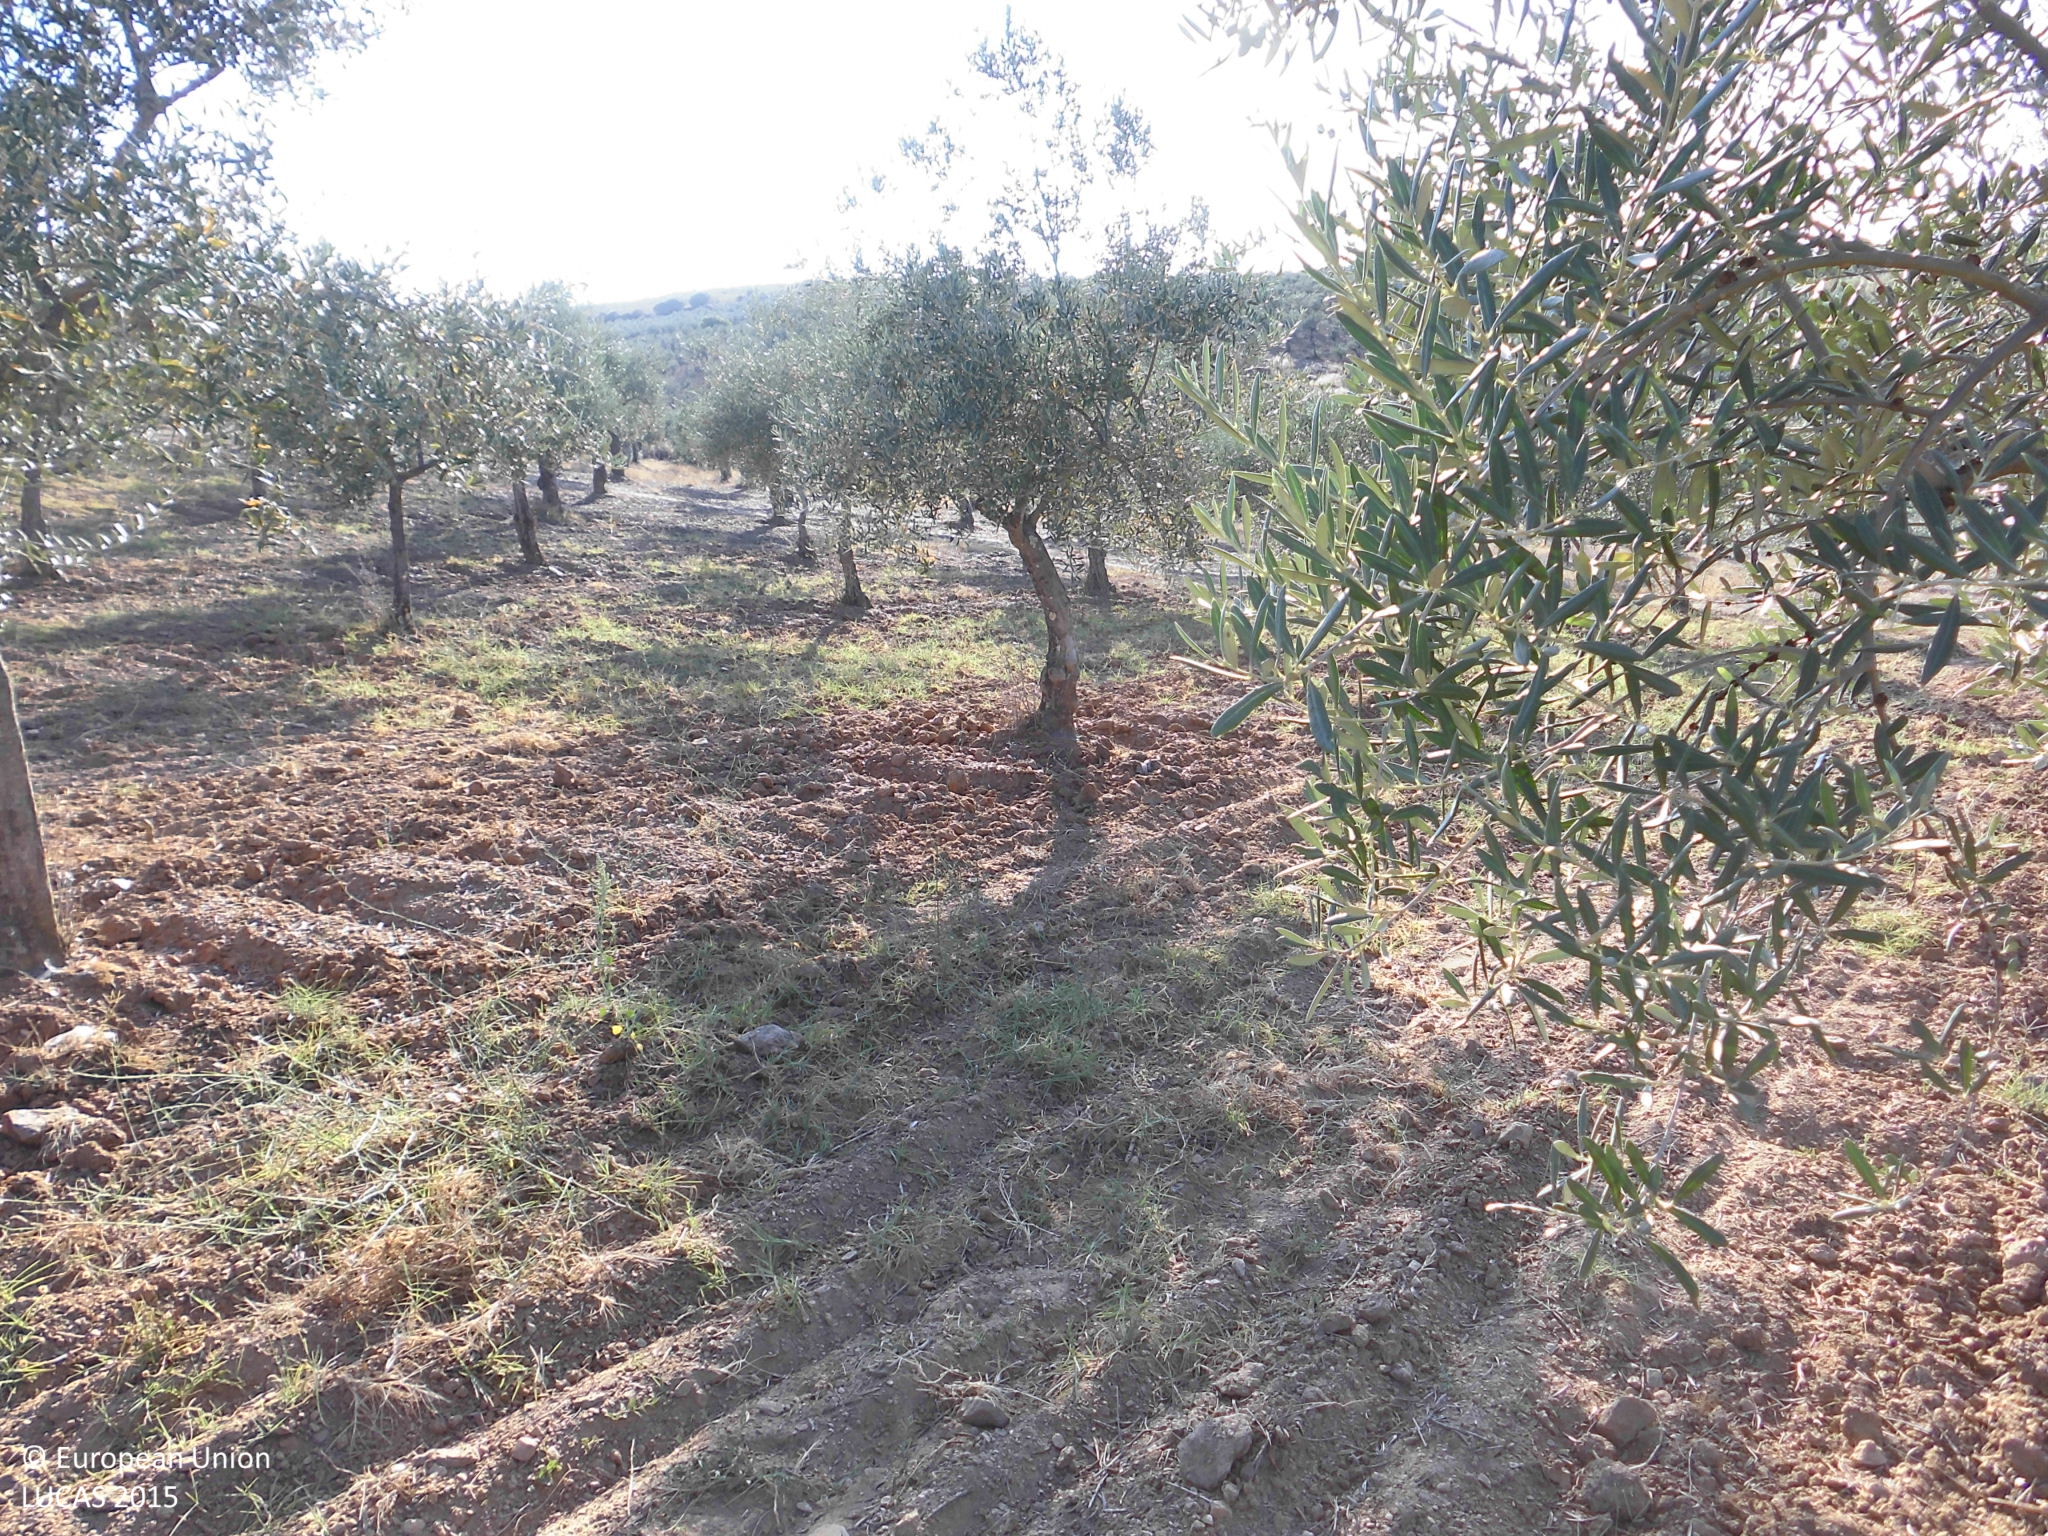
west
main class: Cropland
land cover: Olive groves
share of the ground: 25 - 50 %
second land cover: Other bare soil
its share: > 75 %
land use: Agriculture (excluding fallow land and kitchen gardens)
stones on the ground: < 10 %
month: July
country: ES
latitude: 40.1632
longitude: -6.1965
